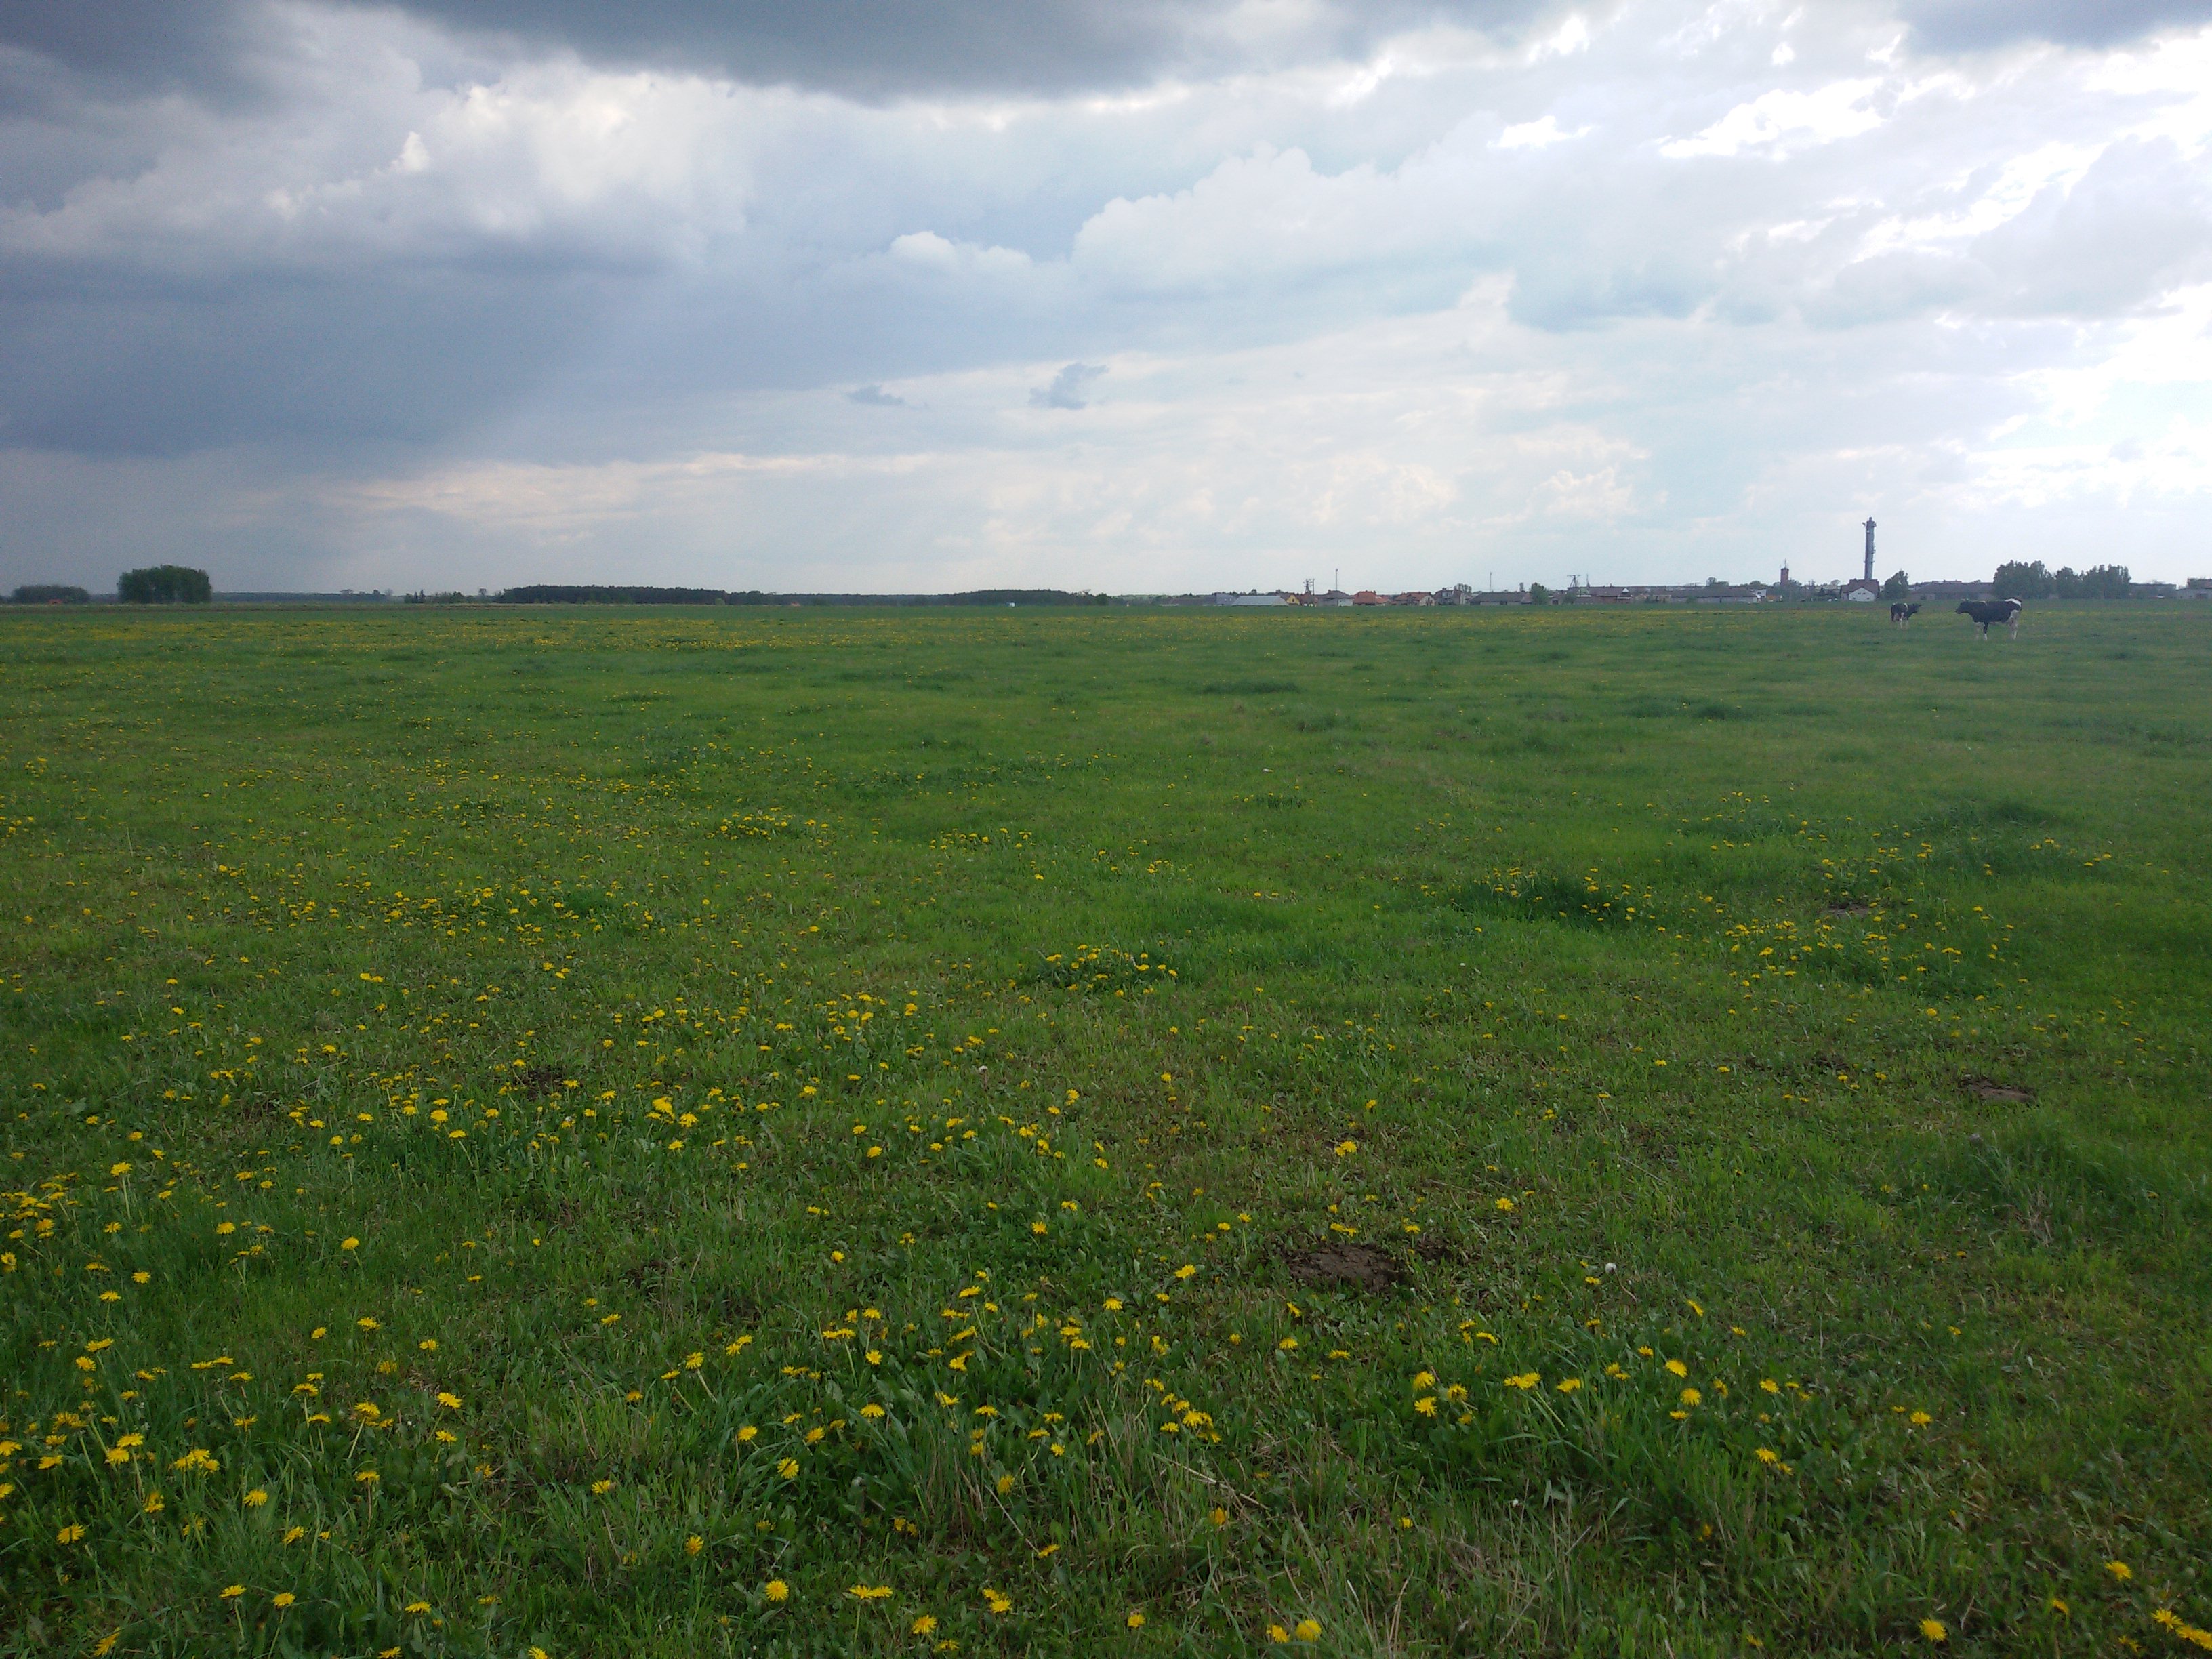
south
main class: Grassland
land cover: Grassland without tree/shrub cover
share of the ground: > 75 %
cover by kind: herbaceous plants 100 %
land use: Agriculture (excluding fallow land and kitchen gardens)
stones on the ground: < 10 %
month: May
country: PL
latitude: 52.9940
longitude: 22.2640
